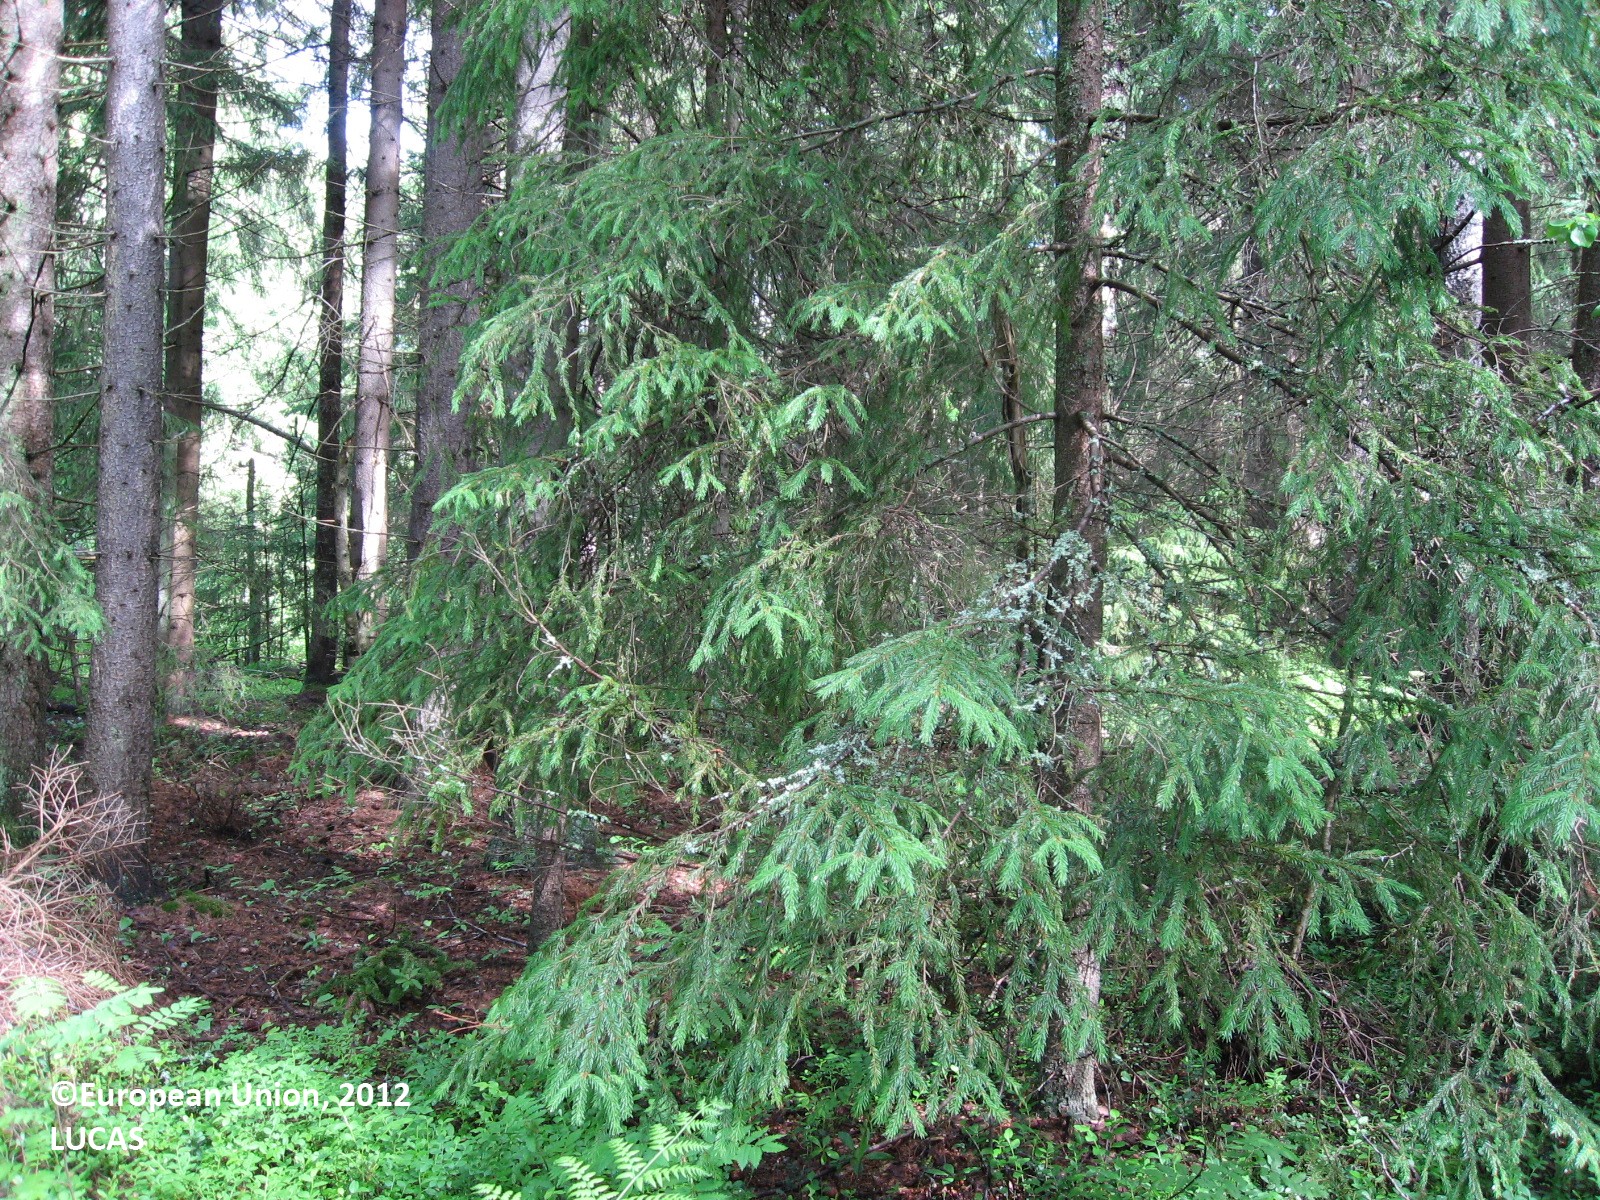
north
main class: Woodland
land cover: Spruce dominated coniferous woodland
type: boreal forest
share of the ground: 50 - 75 %
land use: Forestry
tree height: > 5 m
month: June
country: FI
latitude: 60.5706
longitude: 26.4469
